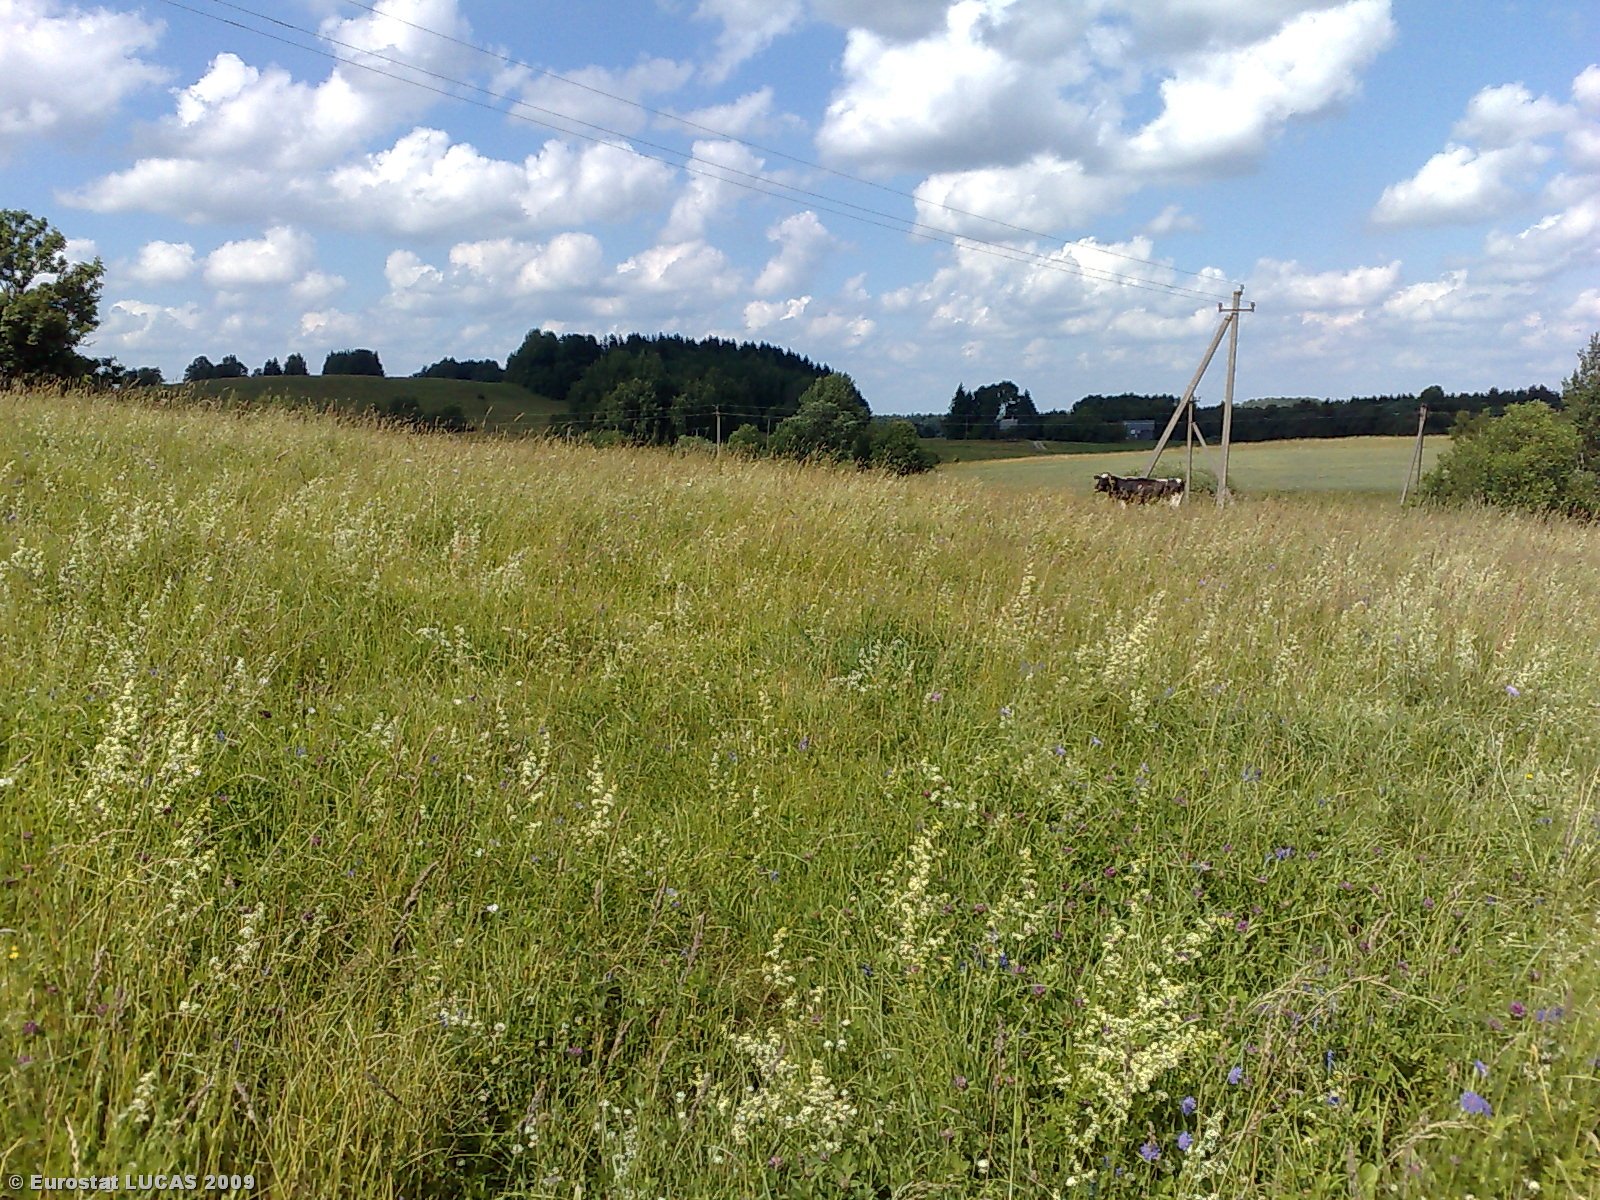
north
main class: Grassland
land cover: Grassland without tree/shrub cover
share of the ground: > 75 %
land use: Agriculture (excluding fallow land and kitchen gardens)
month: July
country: LT
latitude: 55.5681
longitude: 22.7354
